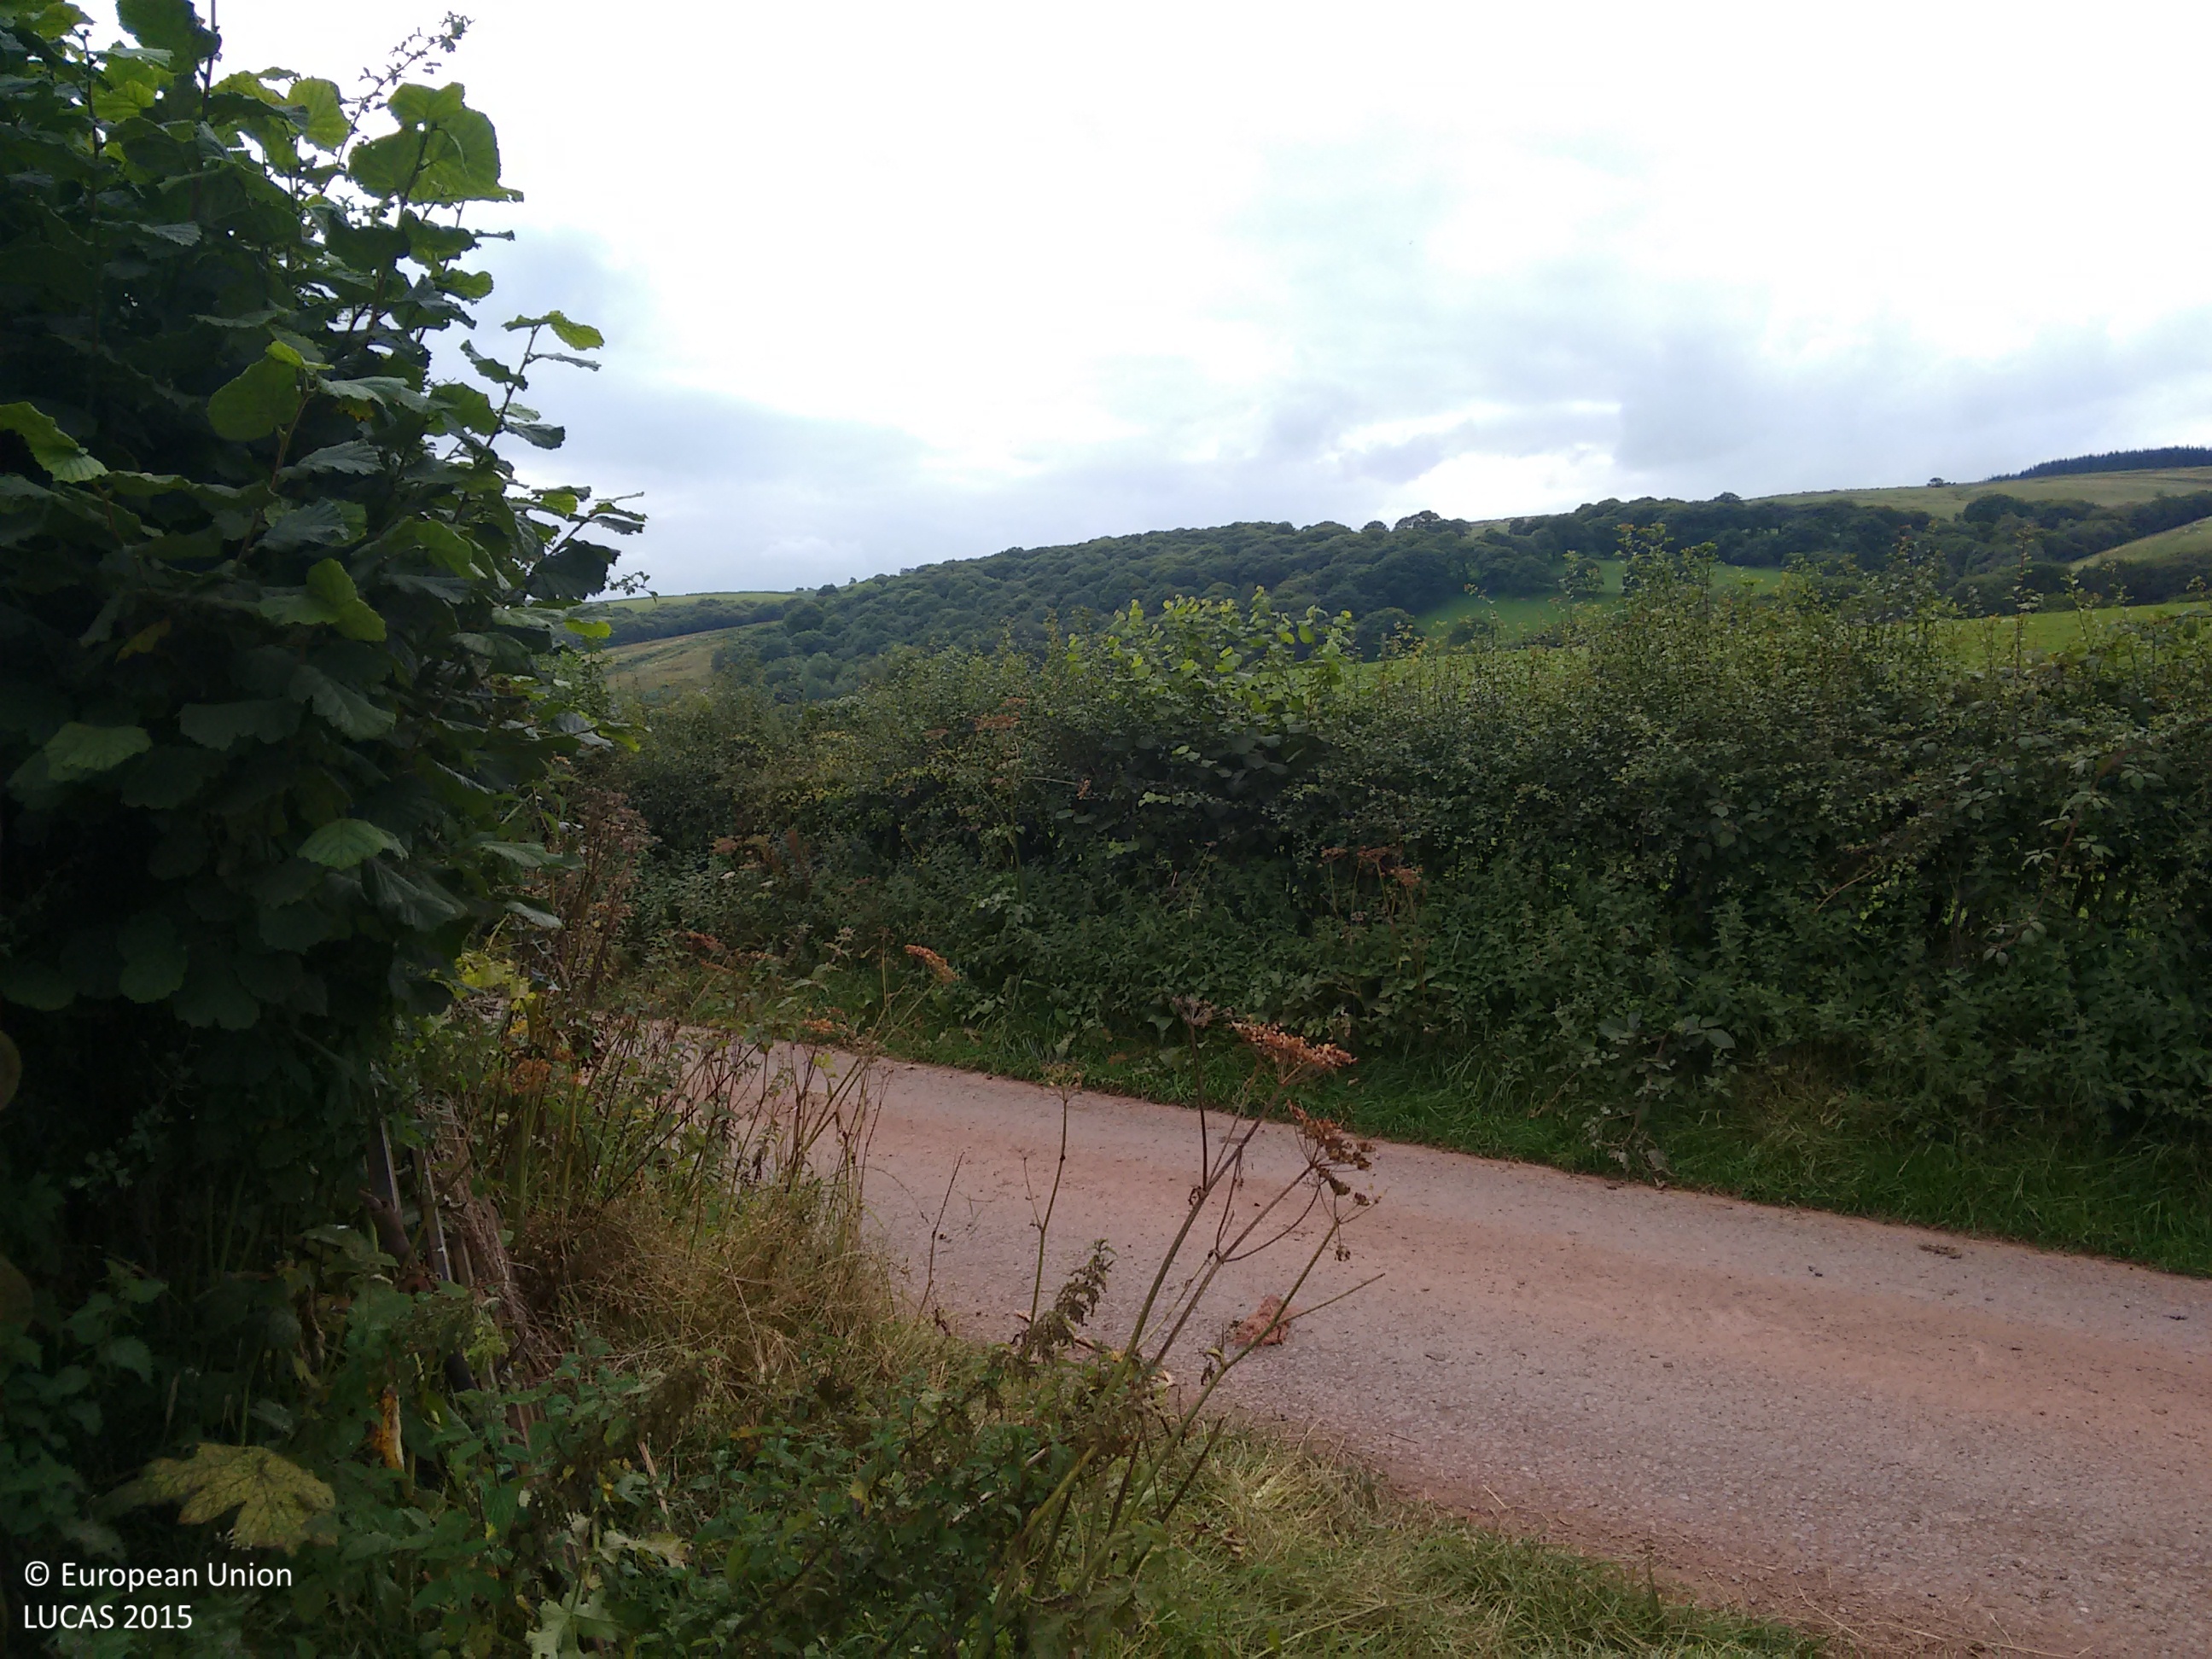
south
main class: Grassland
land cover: Grassland without tree/shrub cover
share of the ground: > 75 %
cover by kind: herbaceous plants 100 %
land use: Agriculture (excluding fallow land and kitchen gardens)
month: September
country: GB
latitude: 52.0623
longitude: -3.4592
